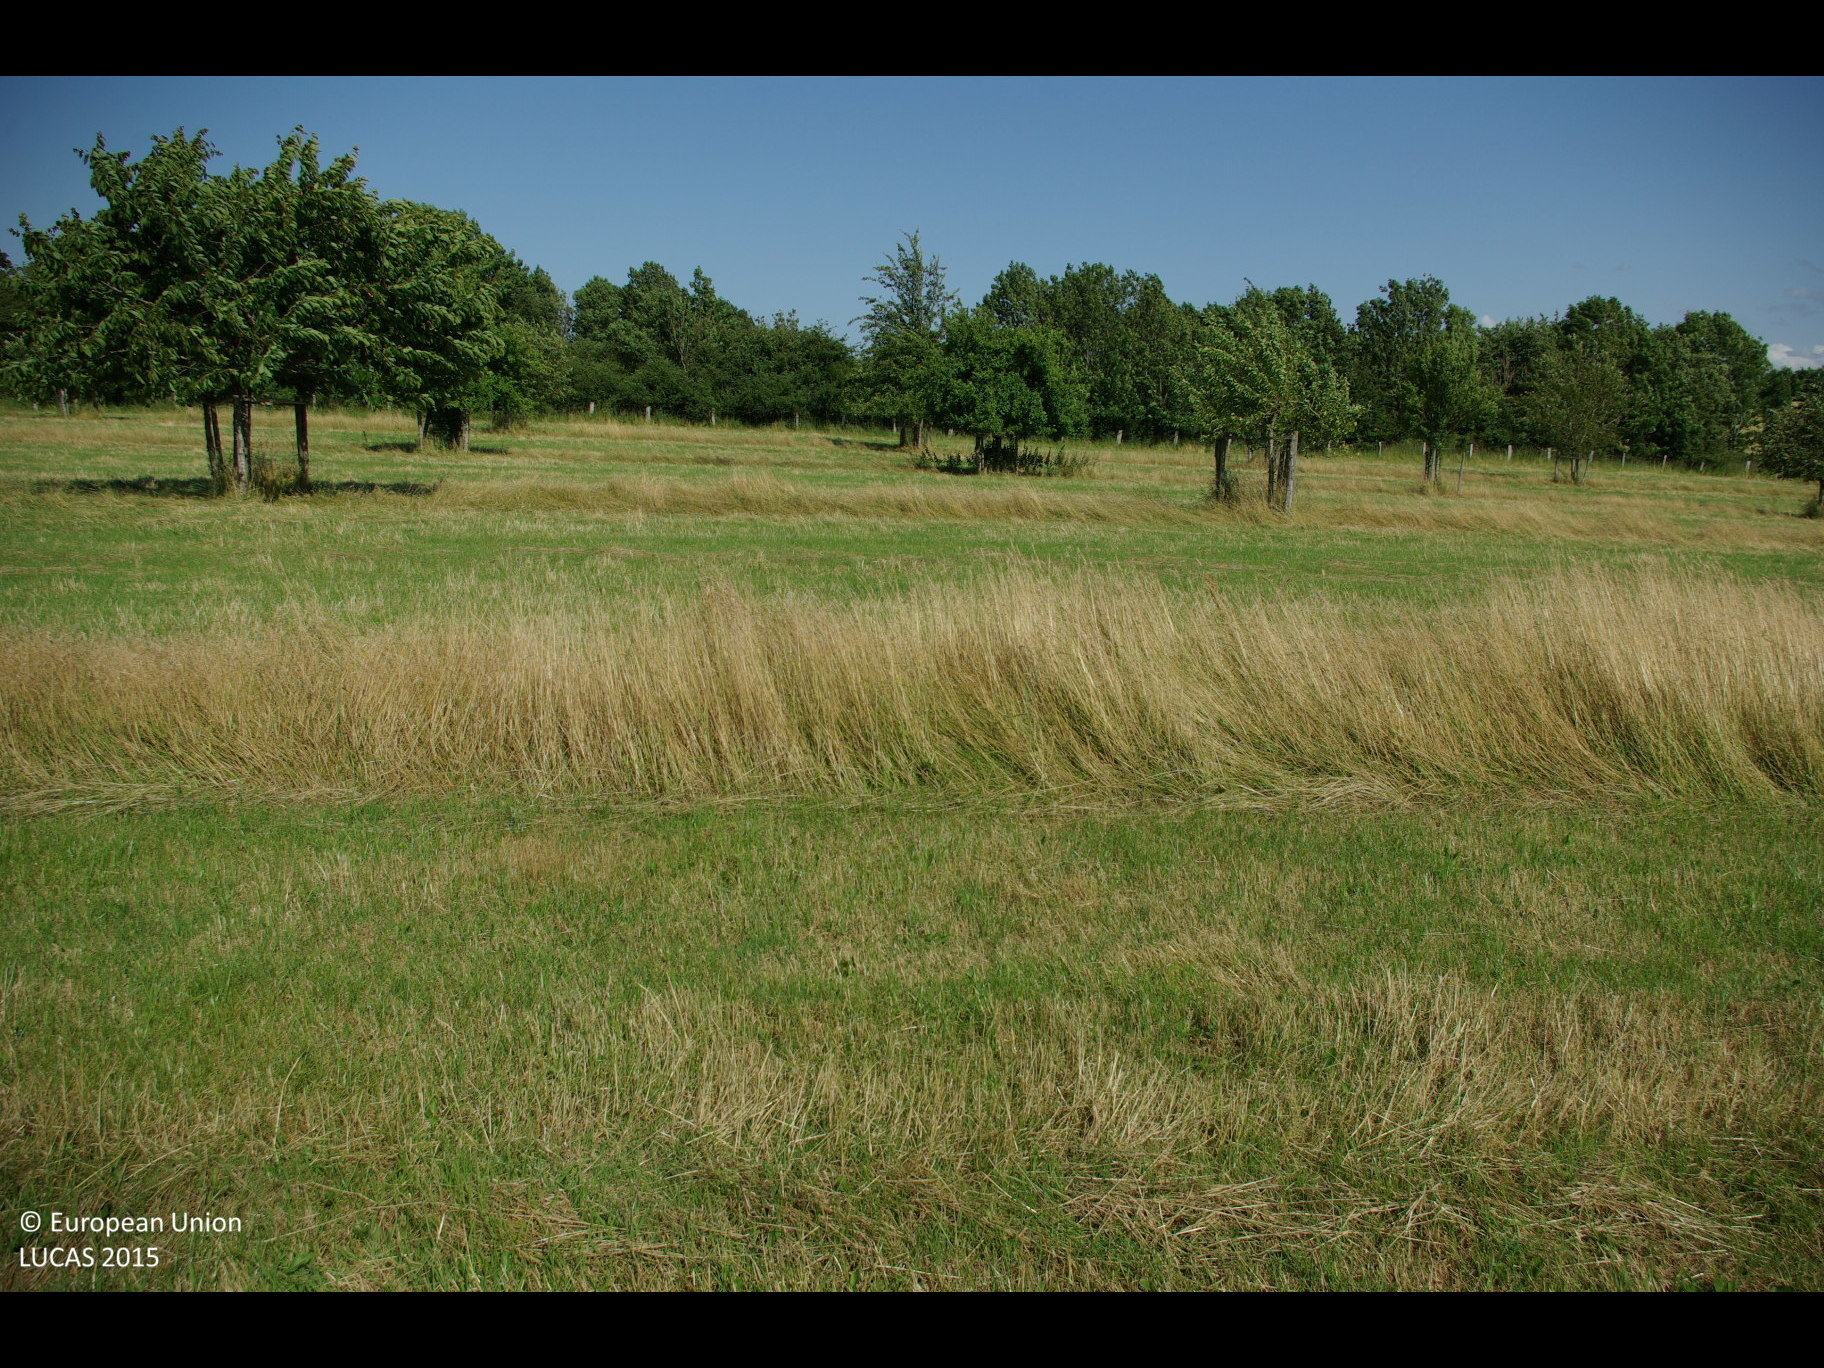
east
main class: Cropland
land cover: Apple fruit
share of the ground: 10 - 25 %
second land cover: Grassland without tree/shrub cover
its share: > 75 %
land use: Agriculture (excluding fallow land and kitchen gardens)
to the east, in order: Apple fruit; Grassland without tree/shrub cover; Fences; Broadleaved woodland; Grassland without tree/shrub cover; Fences; Grassland with sparse tree/shrub cover; Fences; Shrubland with sparse tree cover; Grassland without tree/shrub cover; Fences; Grassland with sparse tree/shrub cover
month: July
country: DE
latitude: 54.5881
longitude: 9.9227
